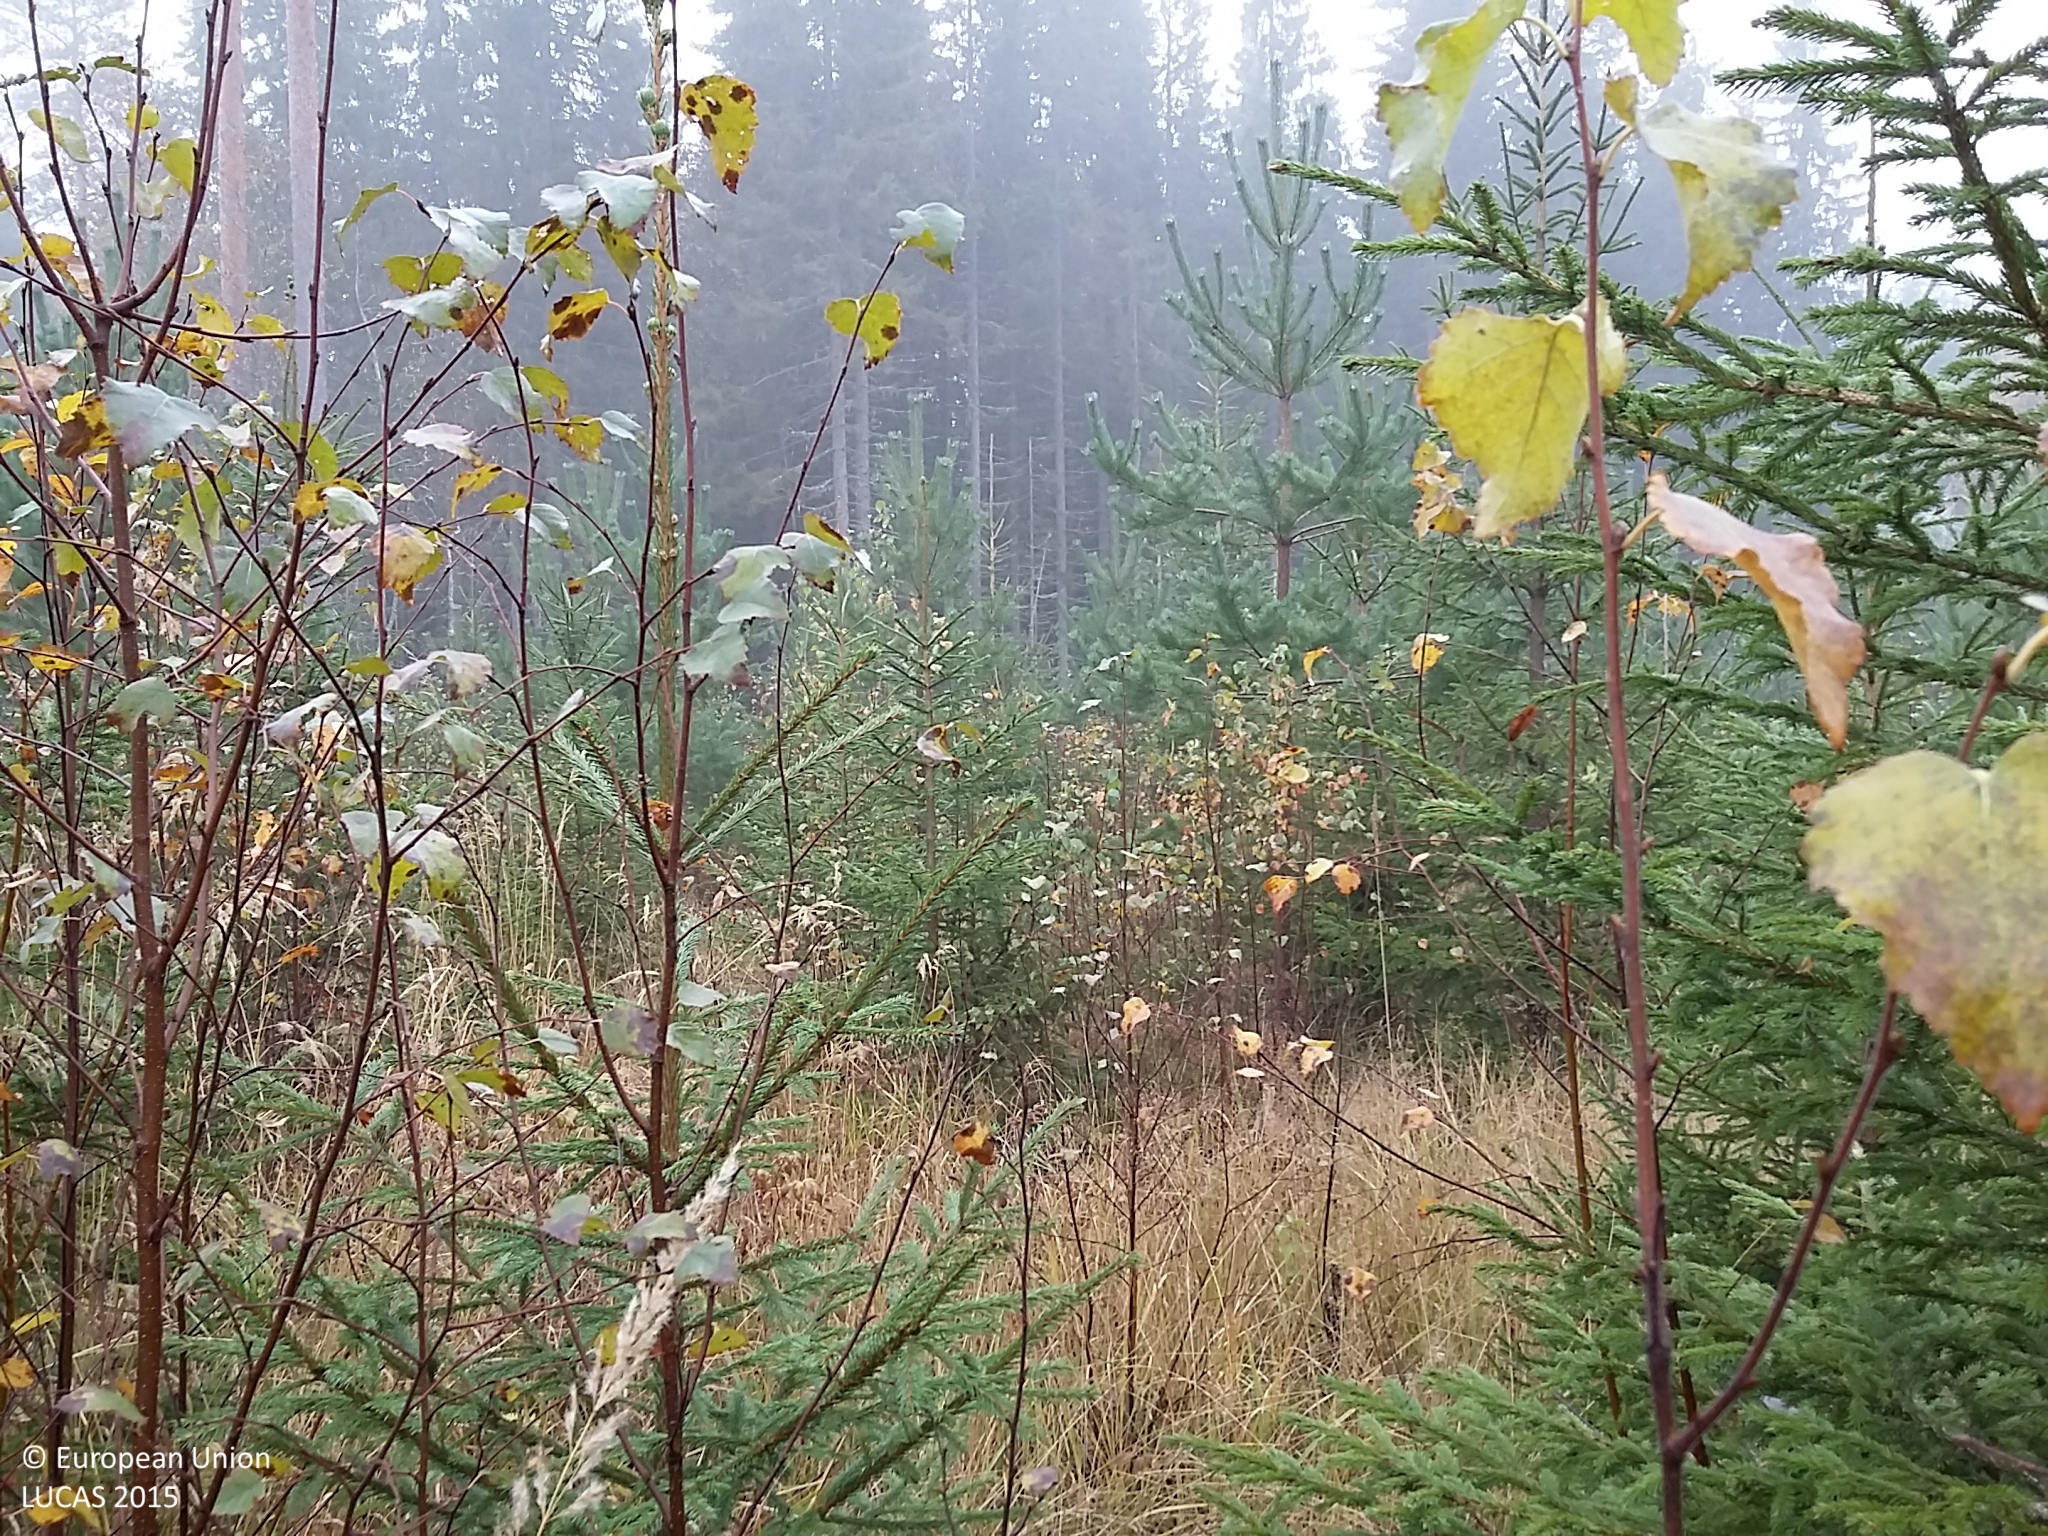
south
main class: Woodland
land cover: Other mixed woodland
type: hemiboreal forest and nemoral coniferous forest and mixed broadleaved-coniferous forest
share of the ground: 50 - 75 %
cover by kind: coniferous forest trees 40 %, broadleaved forest trees 30 %, herbaceous plants 15 %, lichens and mosses 15 %
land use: Forestry
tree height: < 5 m
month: October
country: FI
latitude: 62.6353
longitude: 26.3369
